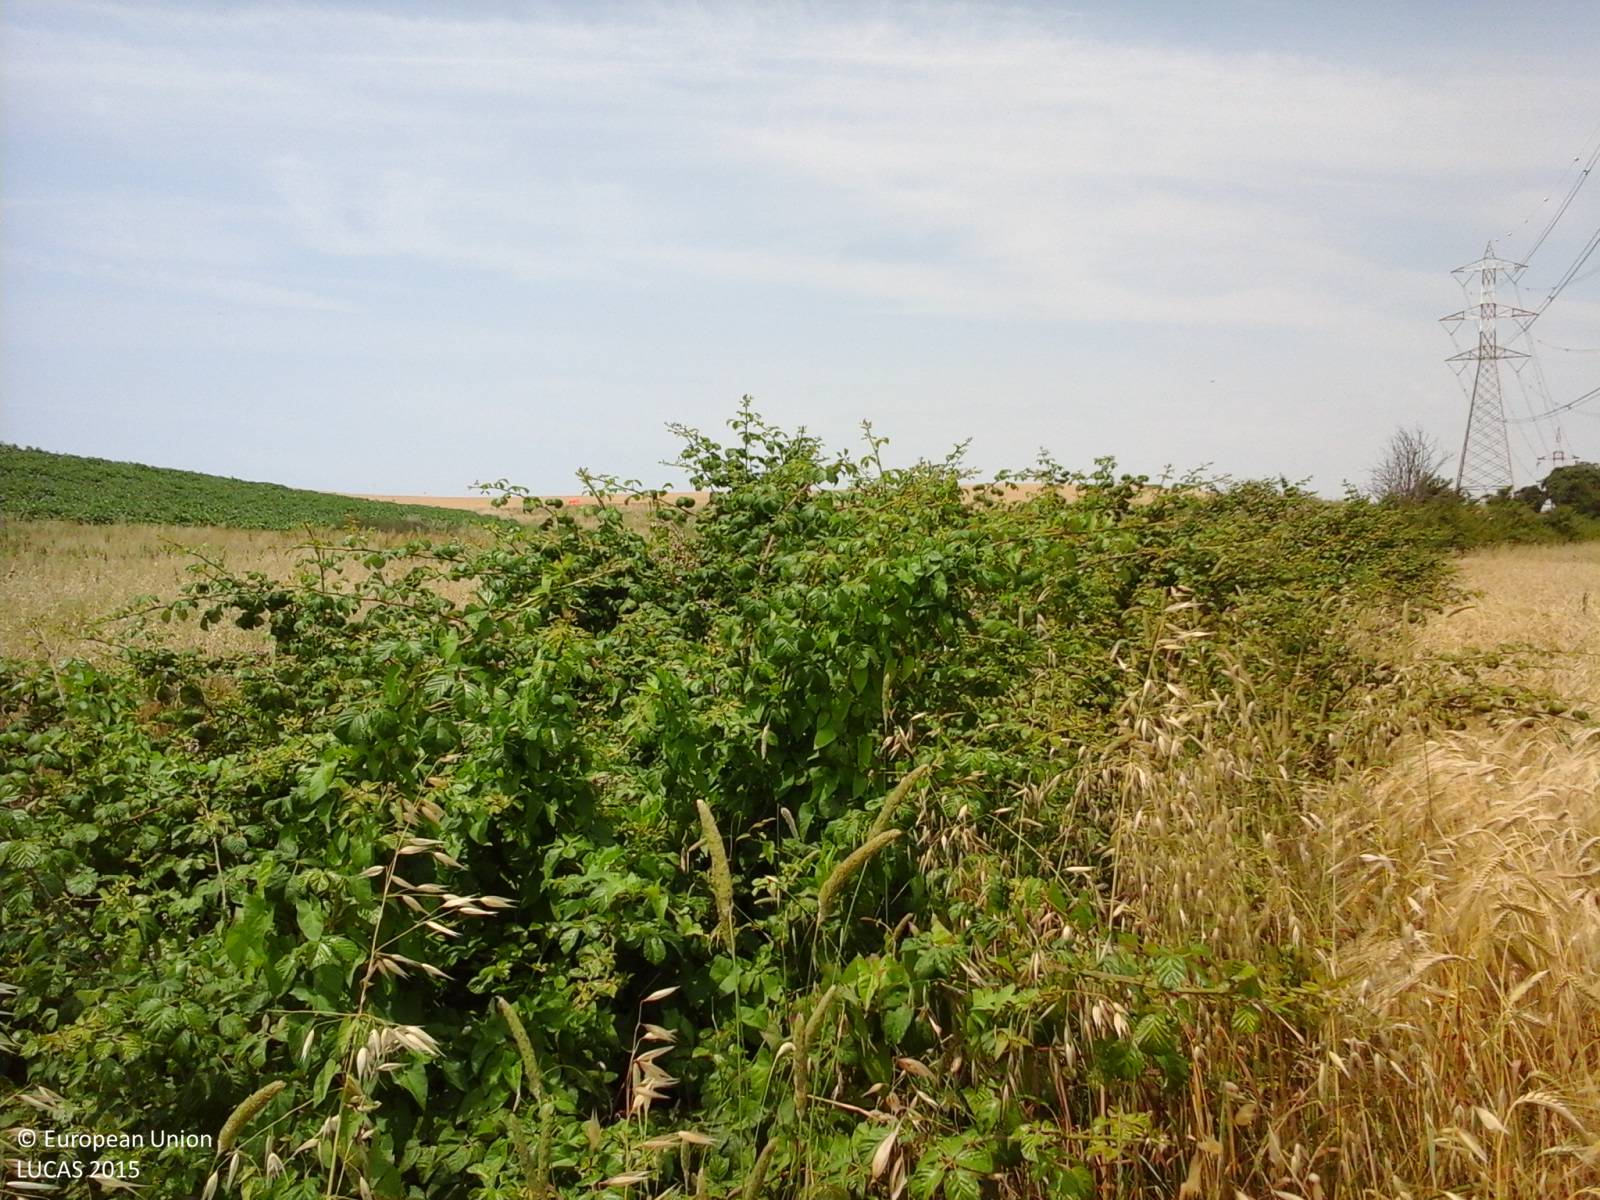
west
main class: Cropland
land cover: Barley
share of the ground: > 75 %
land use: Agriculture (excluding fallow land and kitchen gardens)
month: June
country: IT
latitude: 42.3702
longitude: 11.6094
